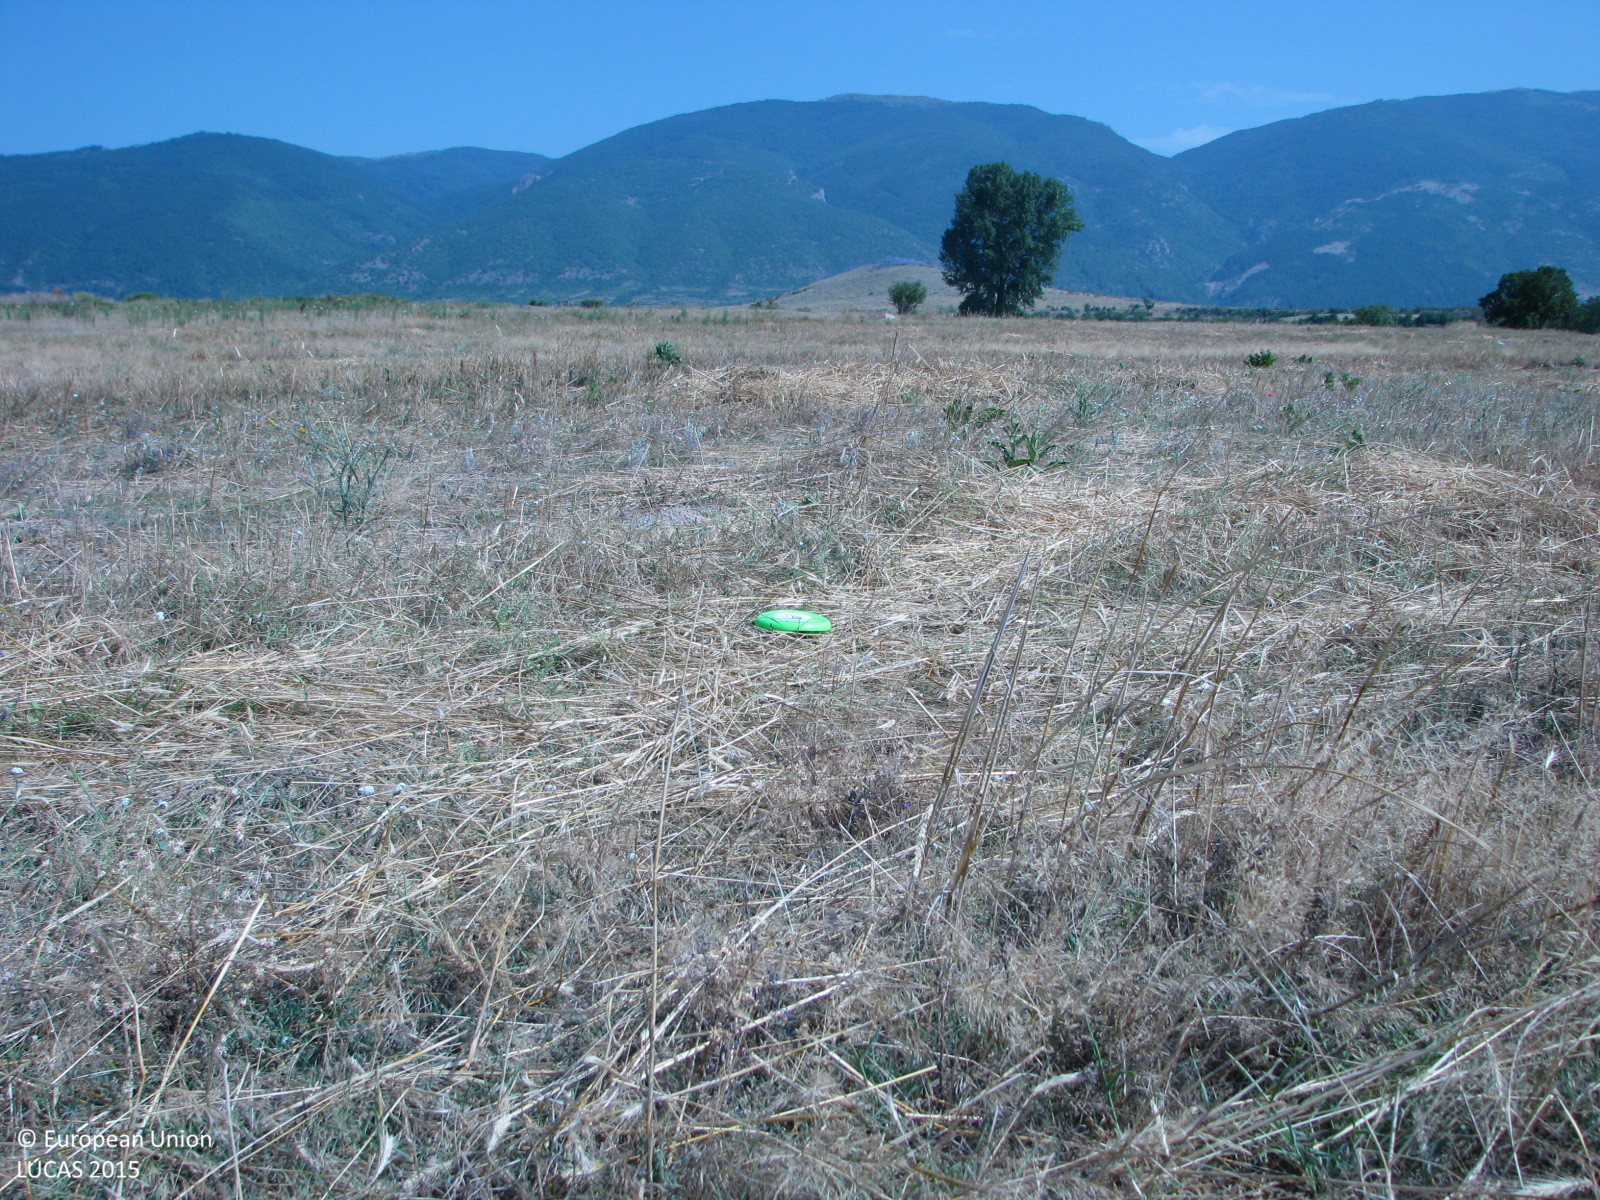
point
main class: Cropland
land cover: Rye
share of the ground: > 75 %
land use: Agriculture (excluding fallow land and kitchen gardens)
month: July
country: BG
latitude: 42.6657
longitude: 25.9551
